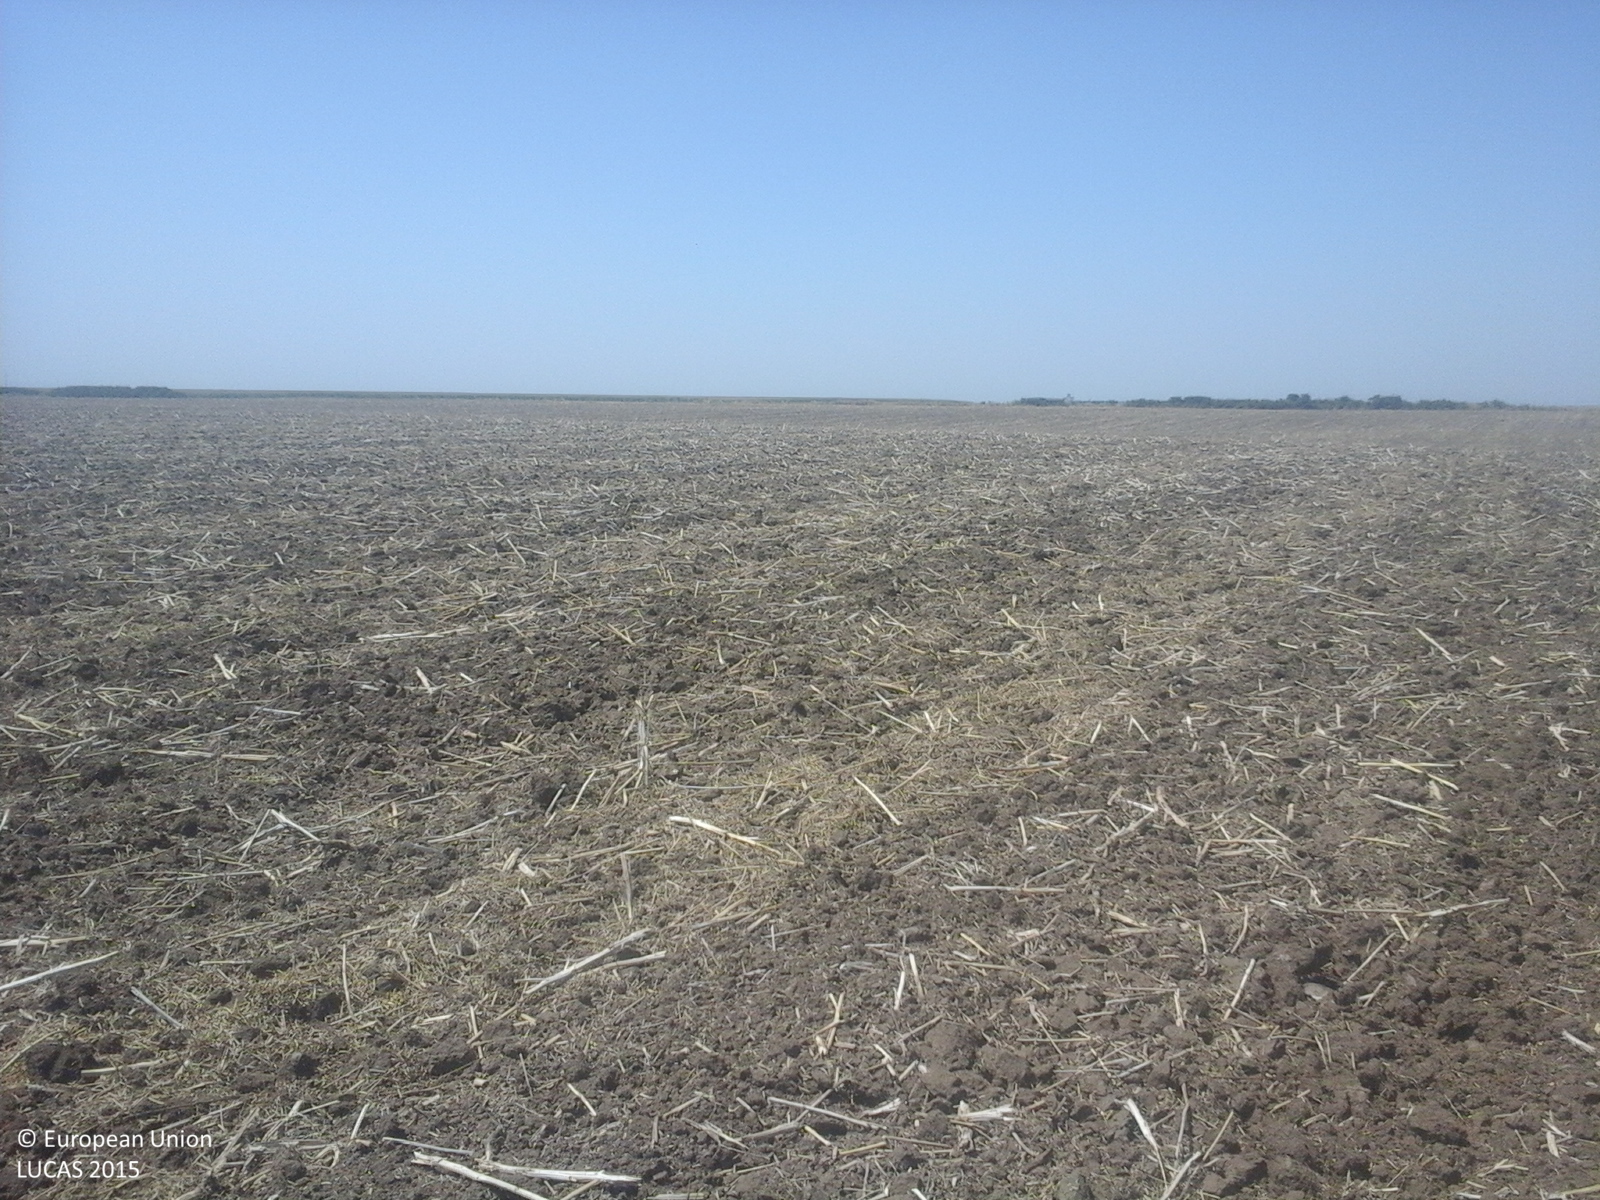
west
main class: Cropland
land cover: Rape and turnip rape
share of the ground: < 10 %
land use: Agriculture (excluding fallow land and kitchen gardens)
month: July
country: RO
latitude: 44.4139
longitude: 26.7358
